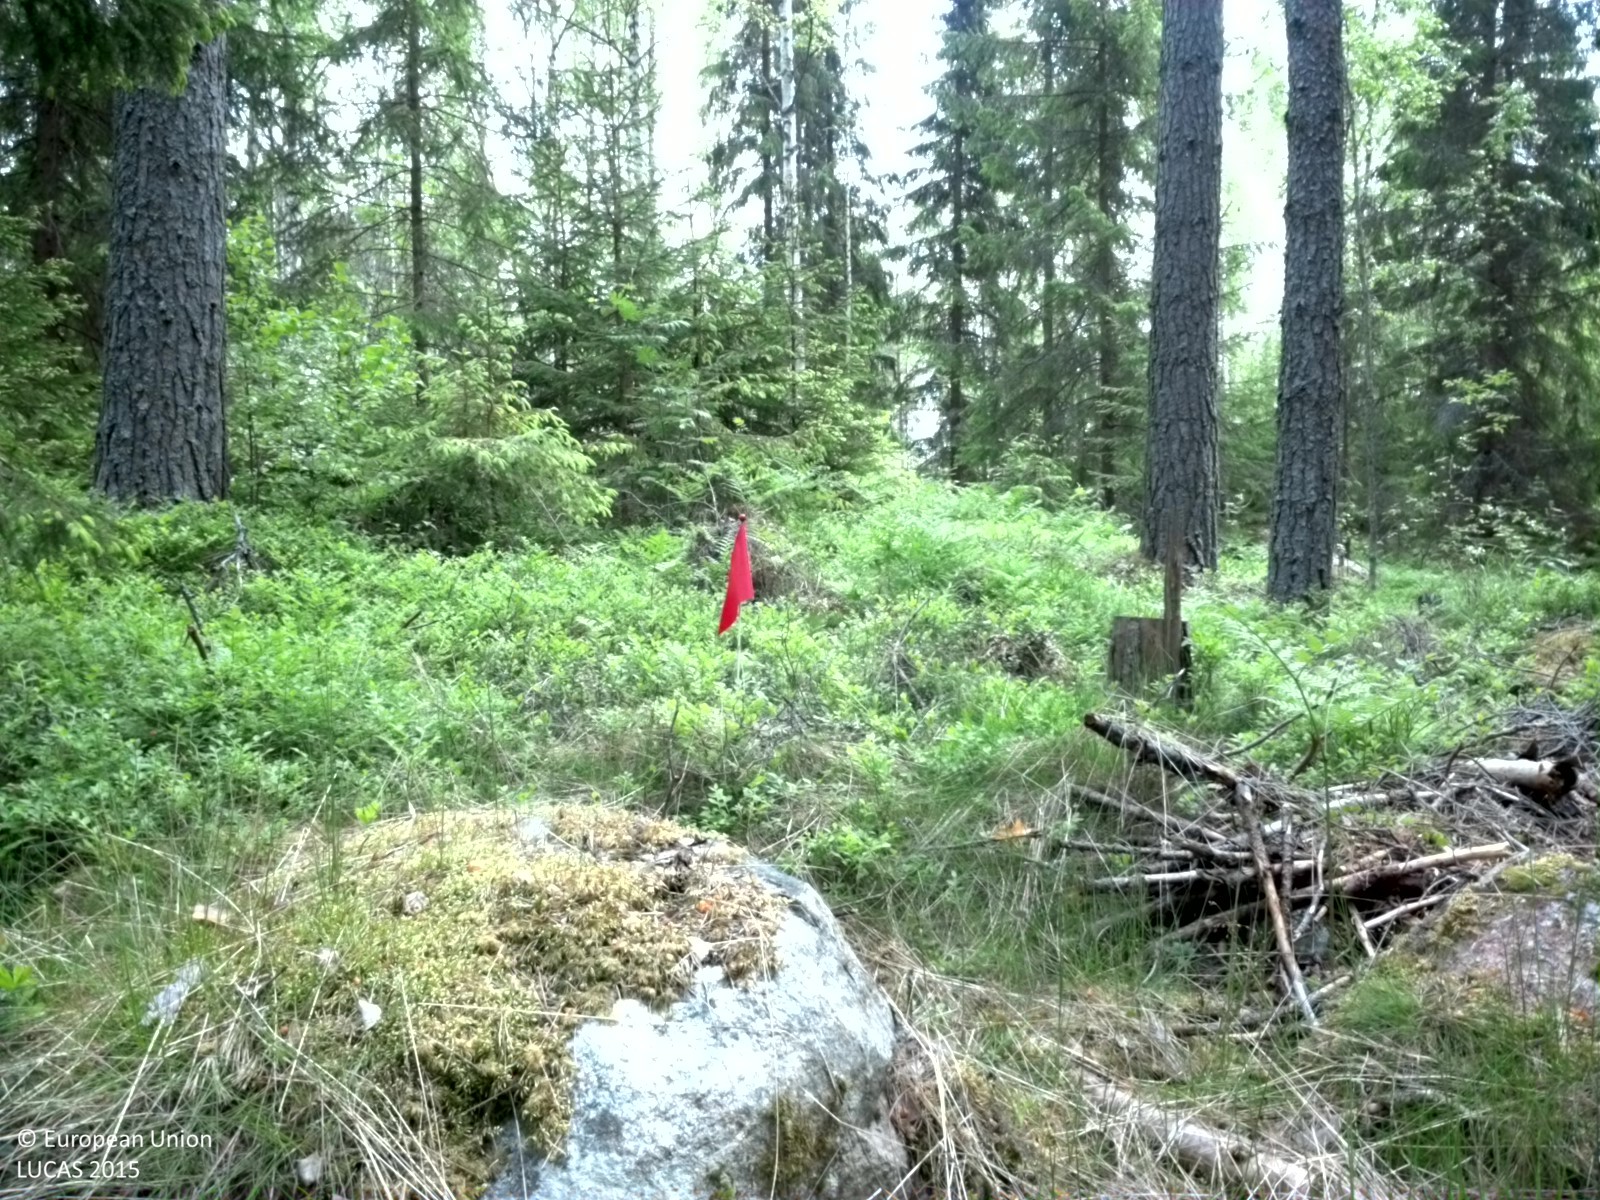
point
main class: Woodland
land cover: Other coniferous woodland
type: boreal forest
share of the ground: 50 - 75 %
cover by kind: coniferous forest trees 50 %, broadleaved forest trees 15 %, shrubs 15 %, herbaceous plants 5 %, lichens and mosses 5 %, consolidated bare surface 5 %
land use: Forestry
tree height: > 5 m
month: June
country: SE
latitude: 60.3287
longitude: 17.0715
